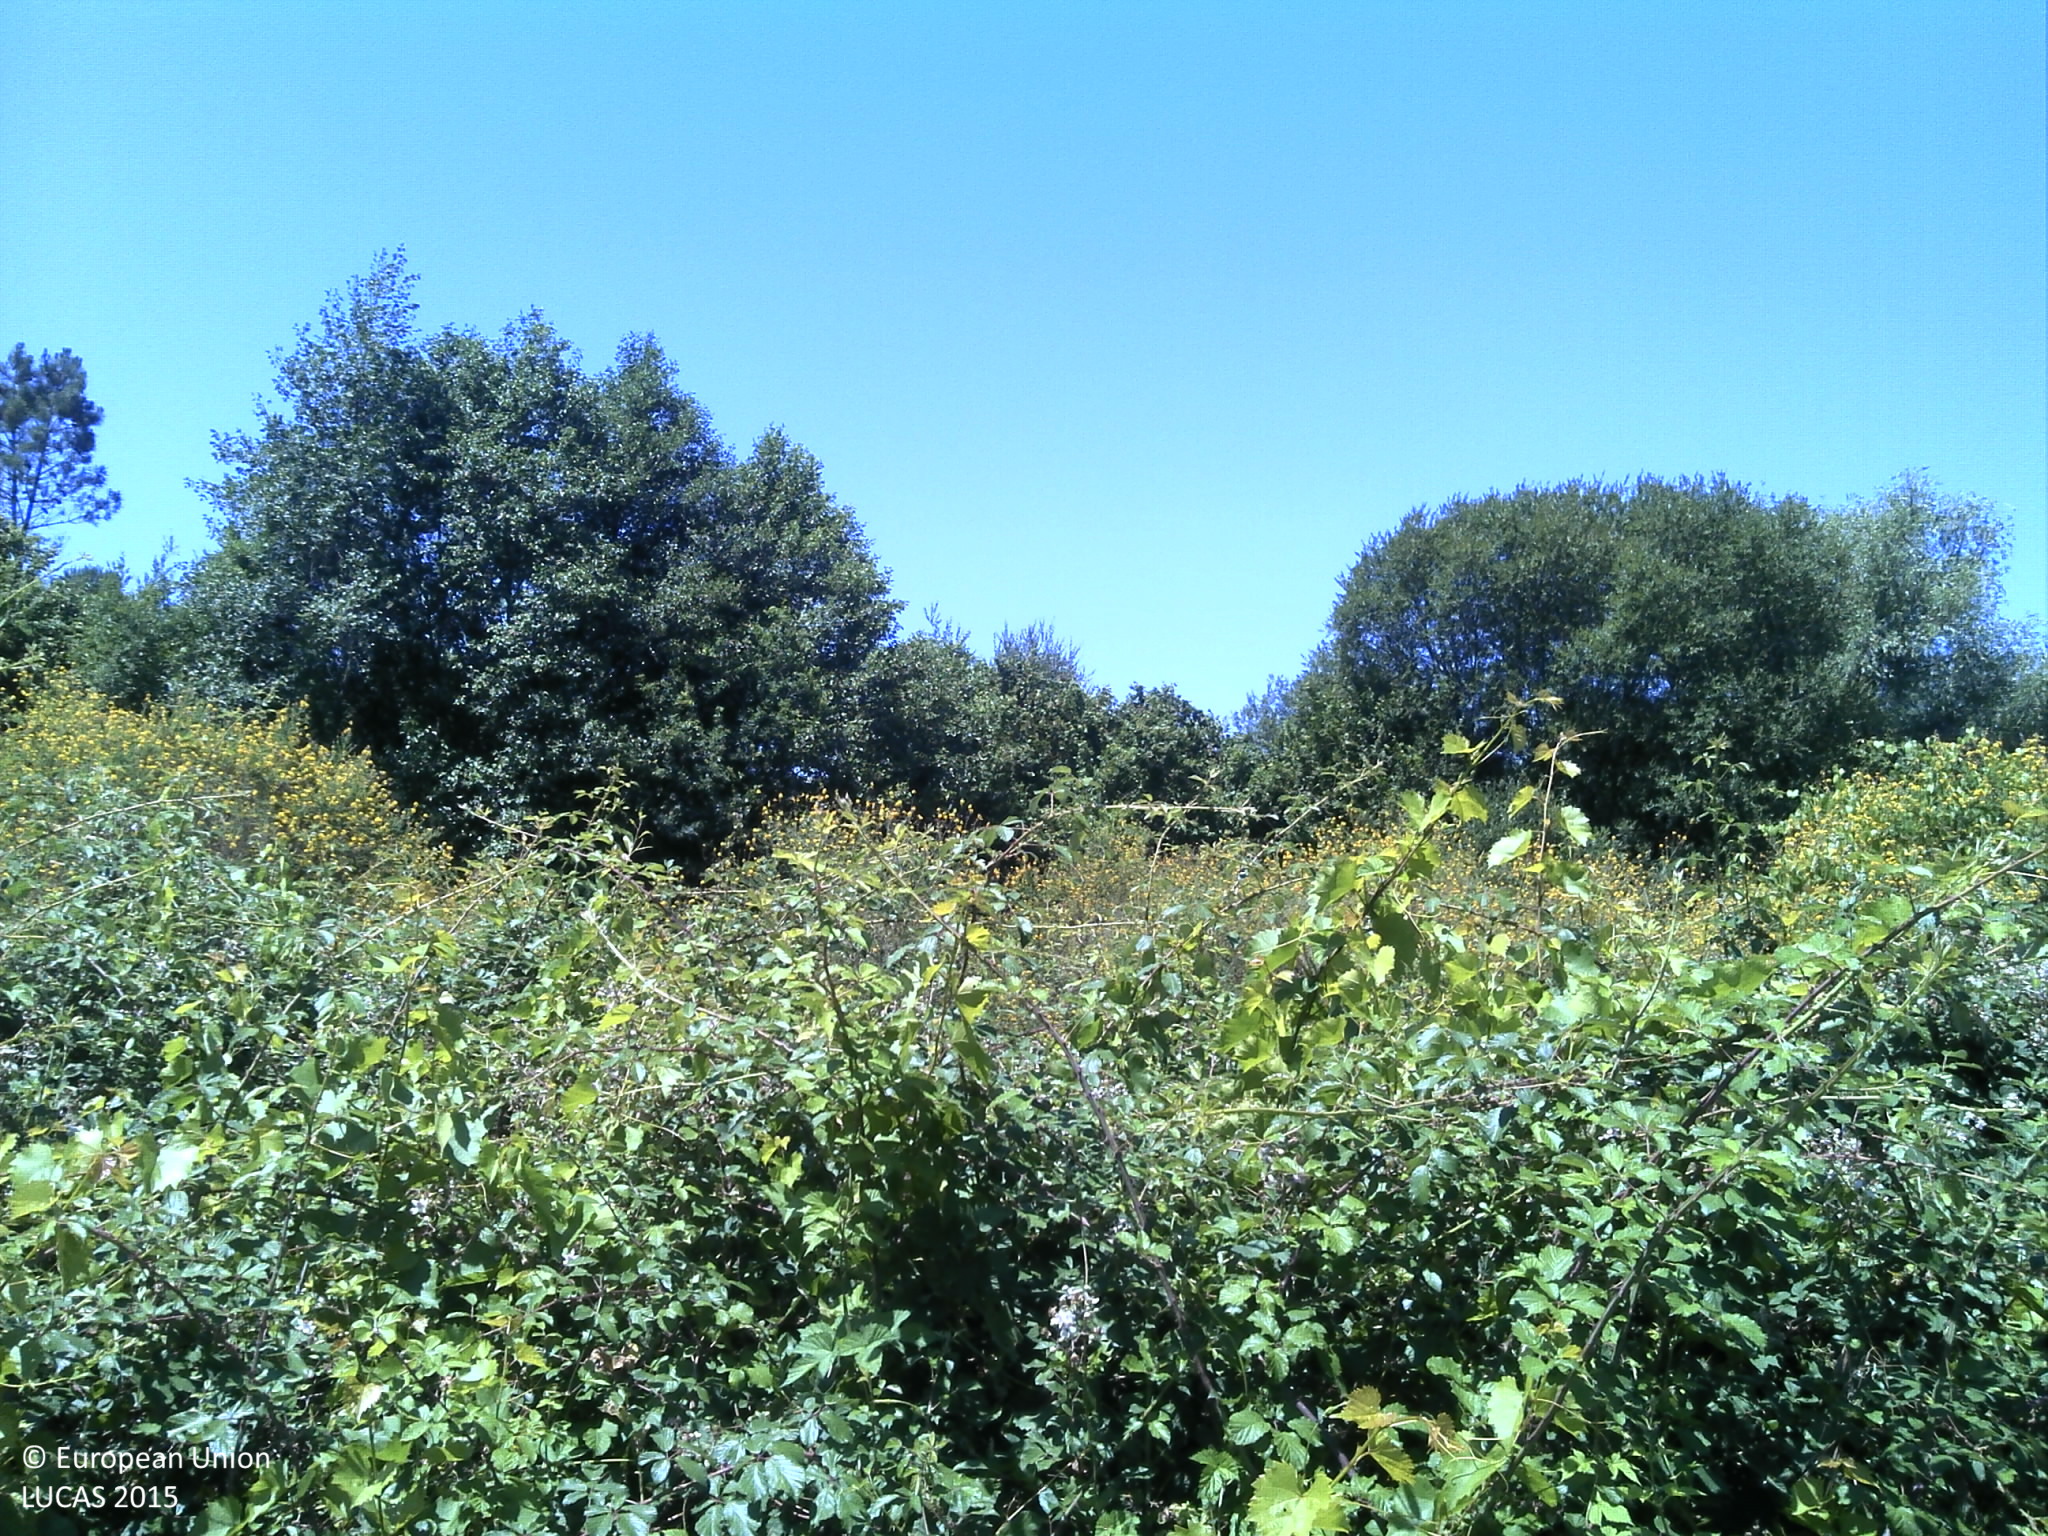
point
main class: Shrubland
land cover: Shrubland without tree cover
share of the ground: > 75 %
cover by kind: shrubs 90 %, unconsolidated bare surface 10 %
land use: Semi-natural and natural areas not in use
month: June
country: PT
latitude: 40.5819
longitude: -7.9031
